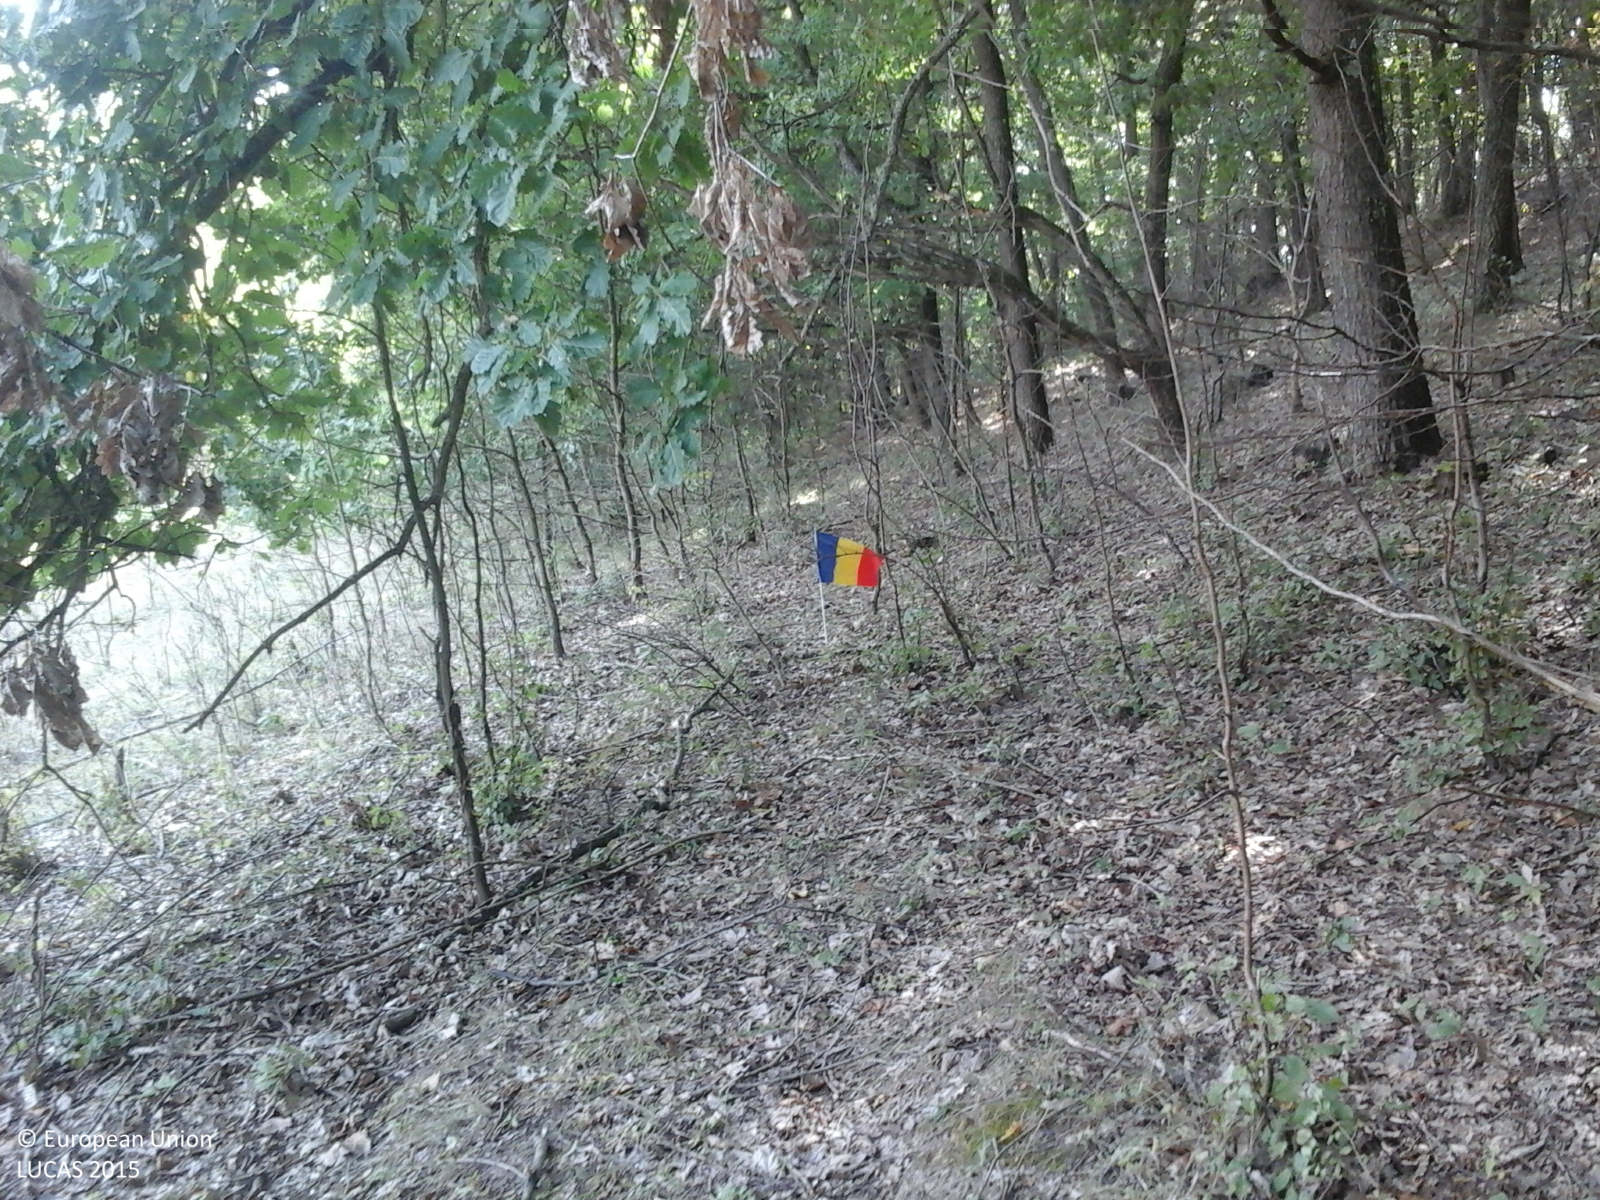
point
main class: Woodland
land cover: Broadleaved woodland
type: mesophytic deciduous forest
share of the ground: > 75 %
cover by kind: broadleaved forest trees 100 %
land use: Forestry
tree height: > 5 m
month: September
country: RO
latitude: 46.9670
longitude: 23.2220
